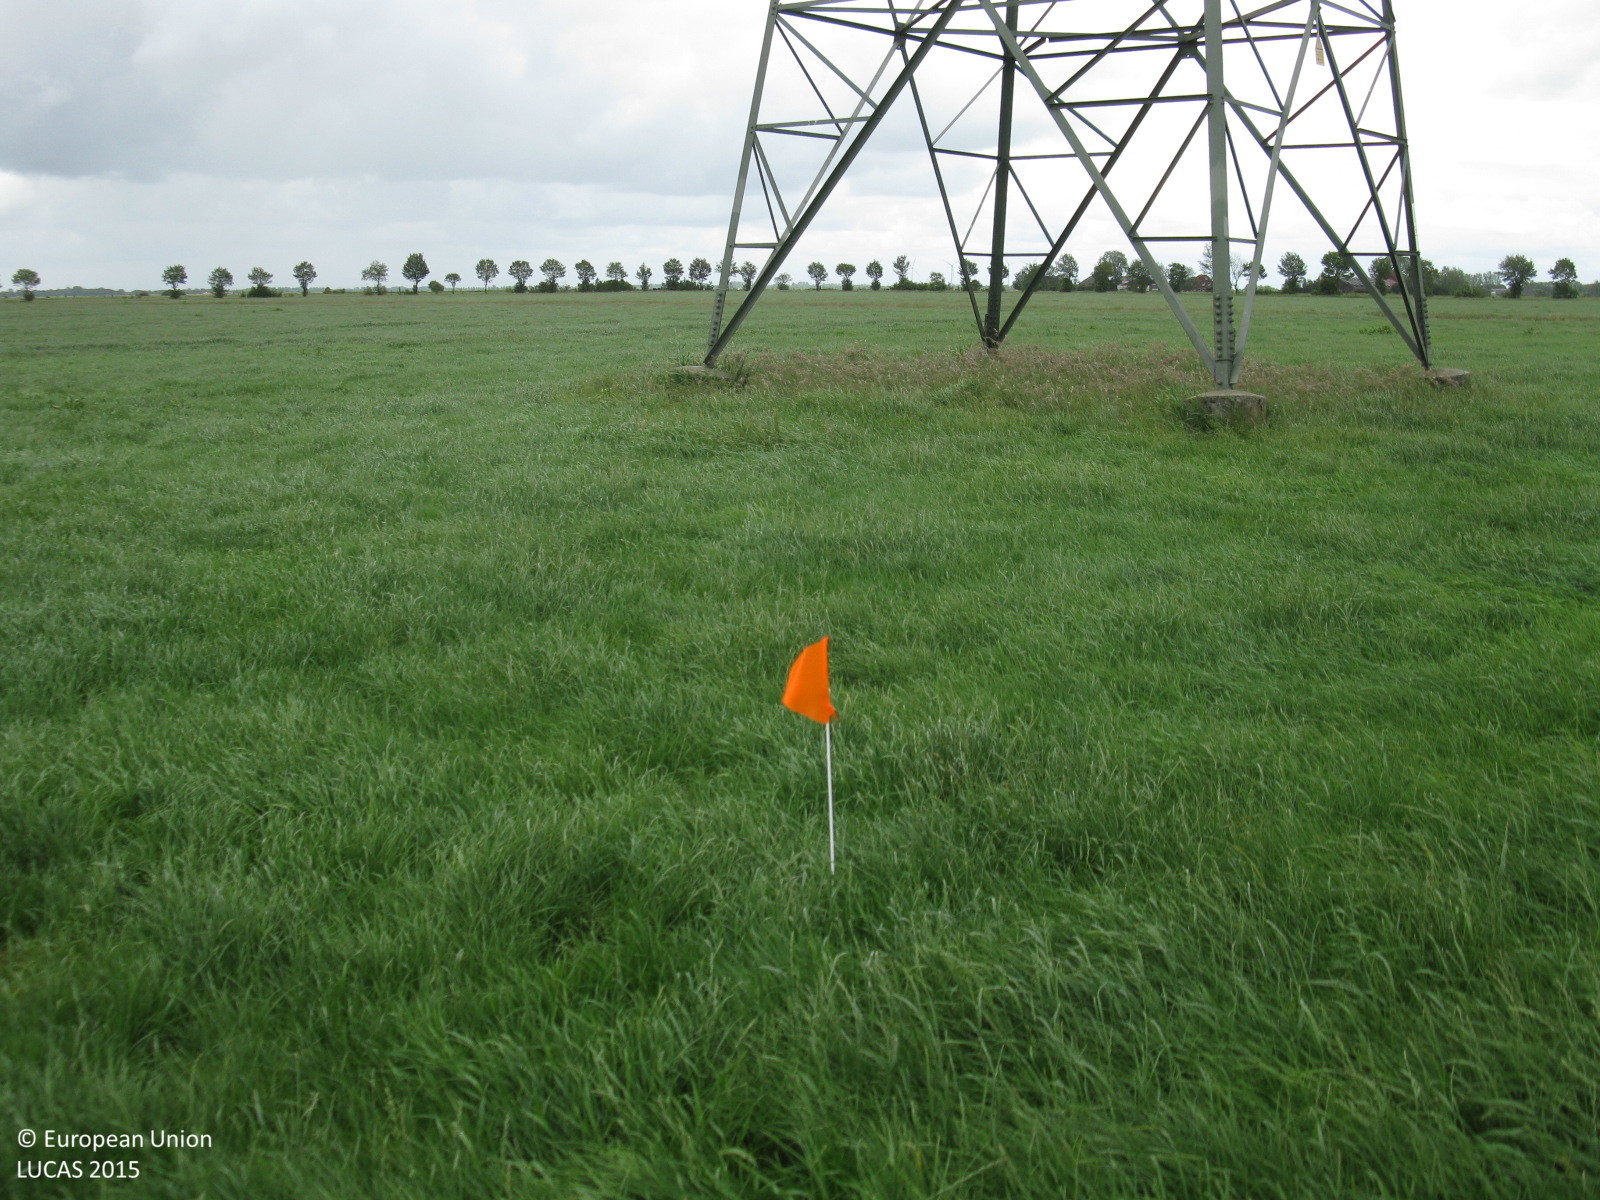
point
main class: Grassland
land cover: Grassland without tree/shrub cover
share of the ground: > 75 %
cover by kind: herbaceous plants 100 %
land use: Agriculture (excluding fallow land and kitchen gardens)
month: June
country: DE
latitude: 53.3554
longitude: 7.3713
